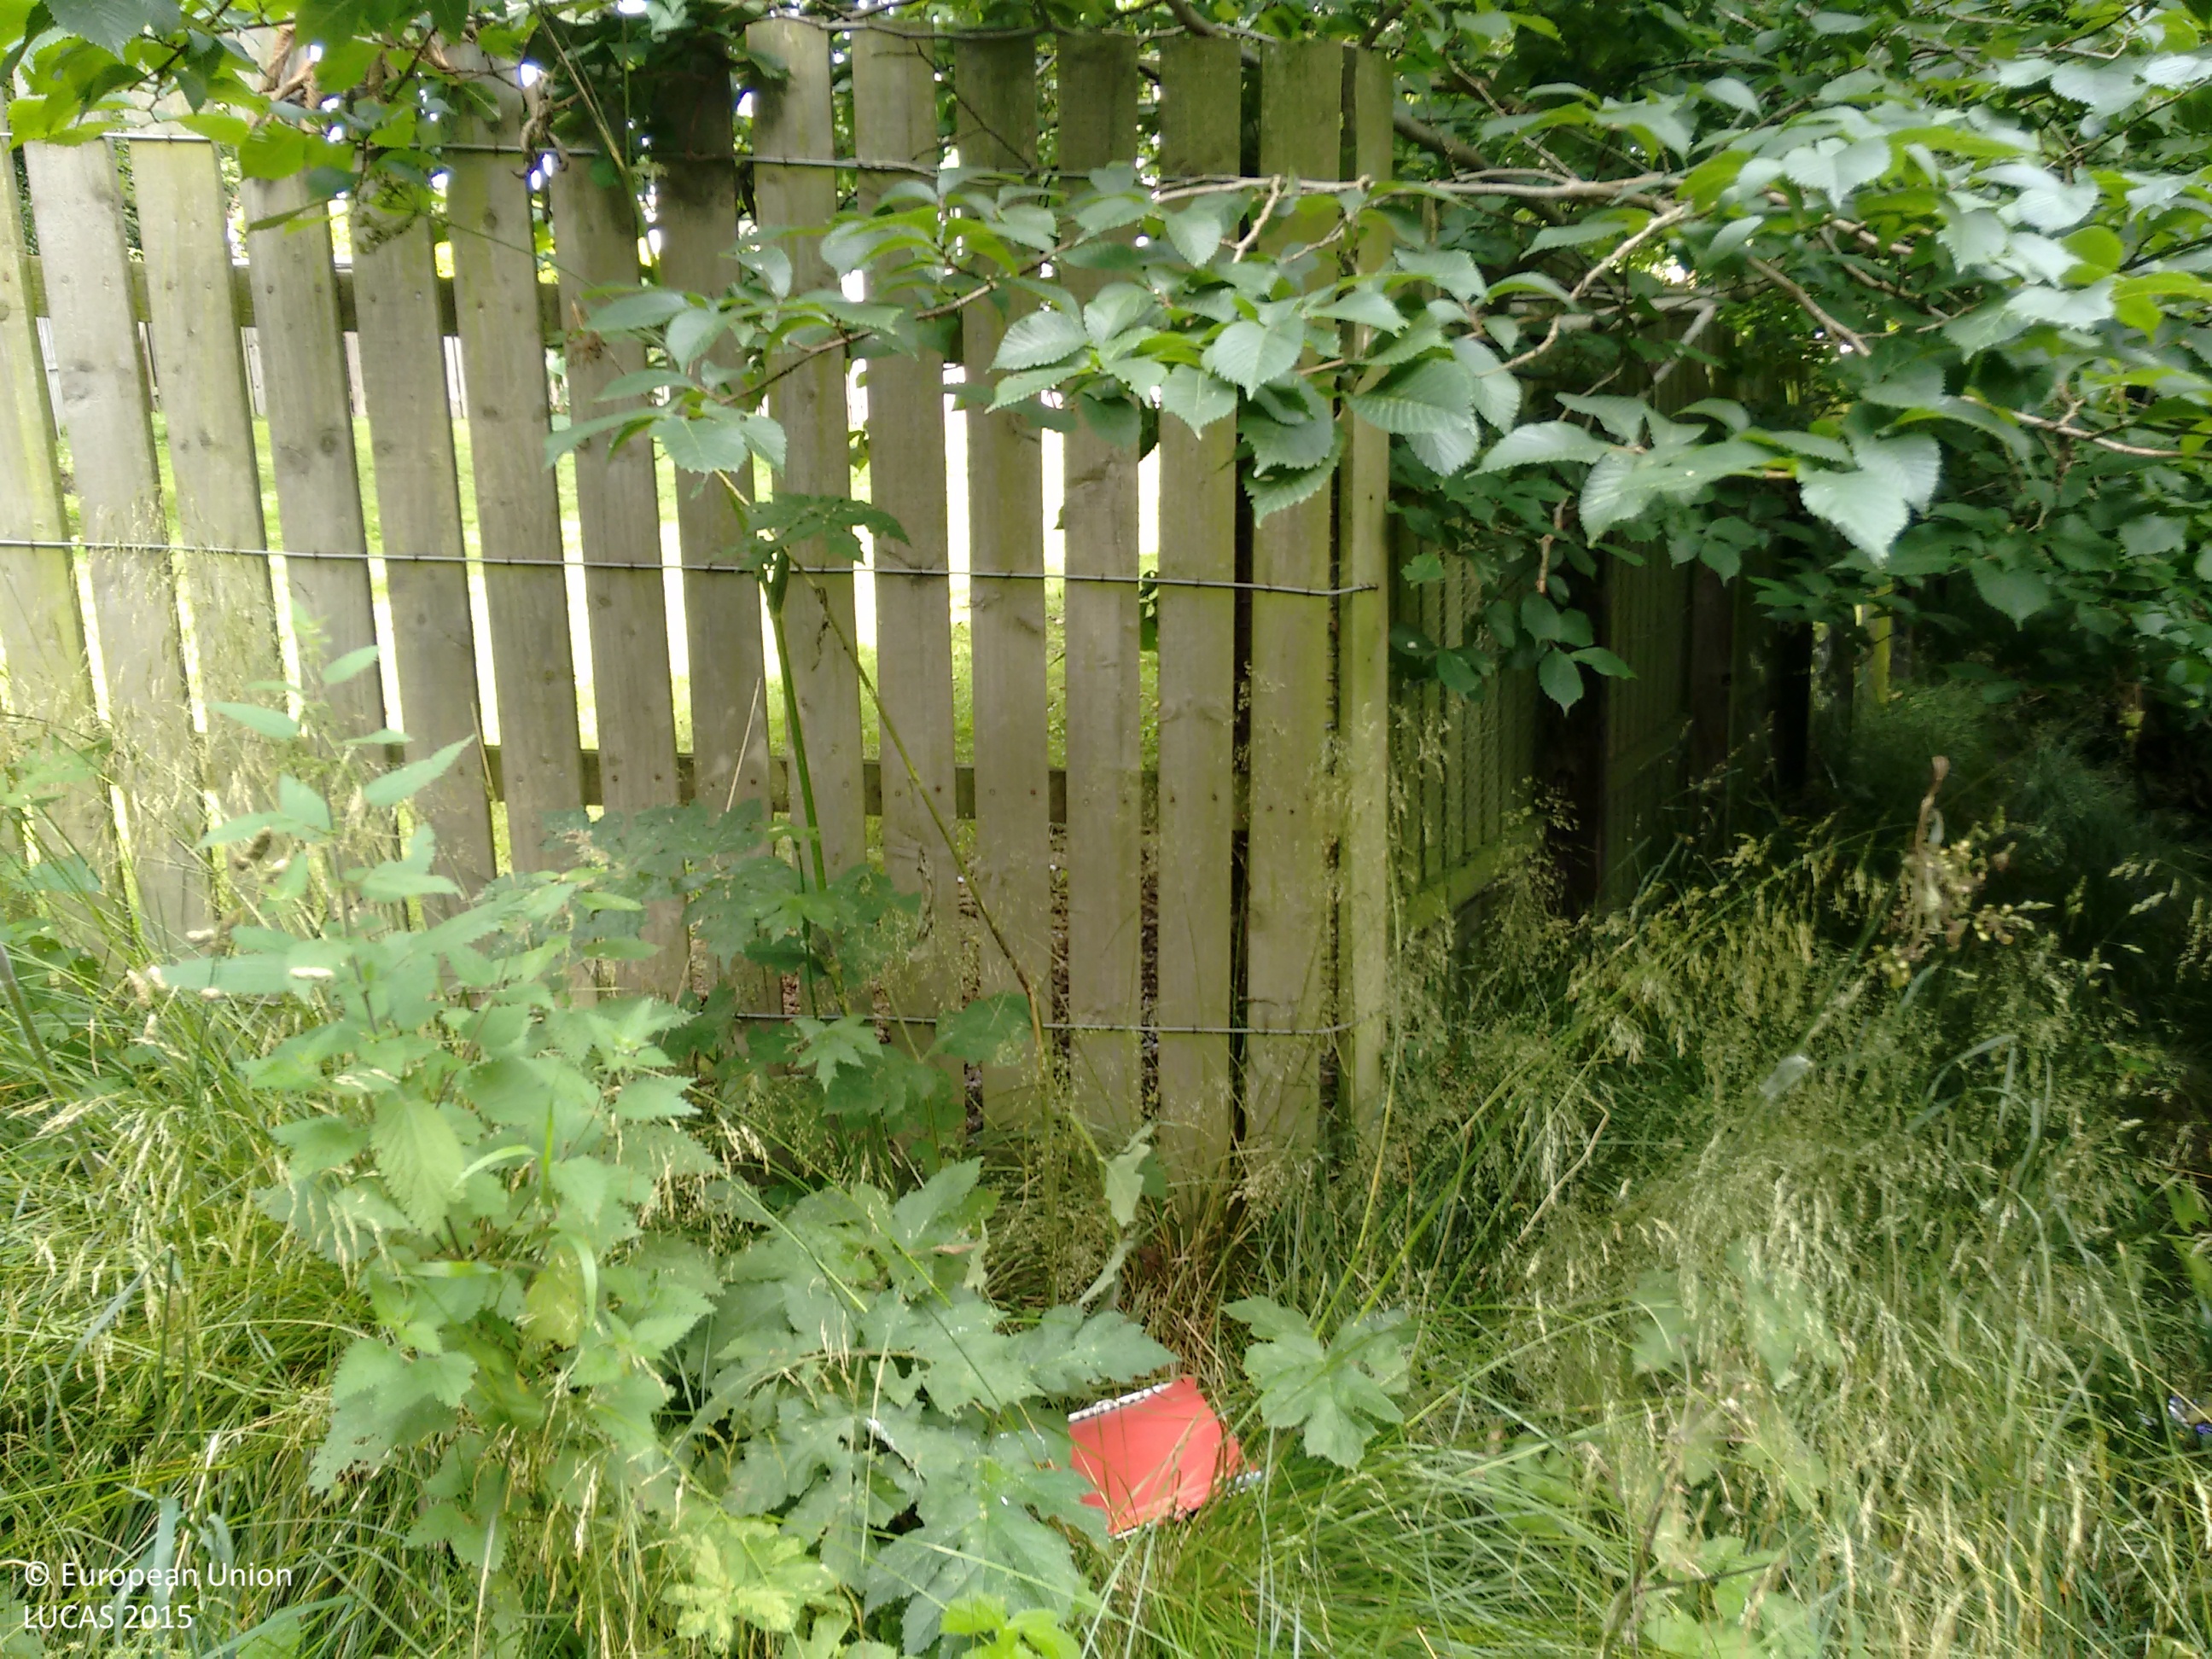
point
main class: Woodland
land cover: Broadleaved woodland
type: mesophytic deciduous forest
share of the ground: > 75 %
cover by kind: broadleaved forest trees 60 %, herbaceous plants 30 %, consolidated bare surface 10 %
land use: Residential
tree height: > 5 m
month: August
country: GB
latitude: 57.1779
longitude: -2.1071
